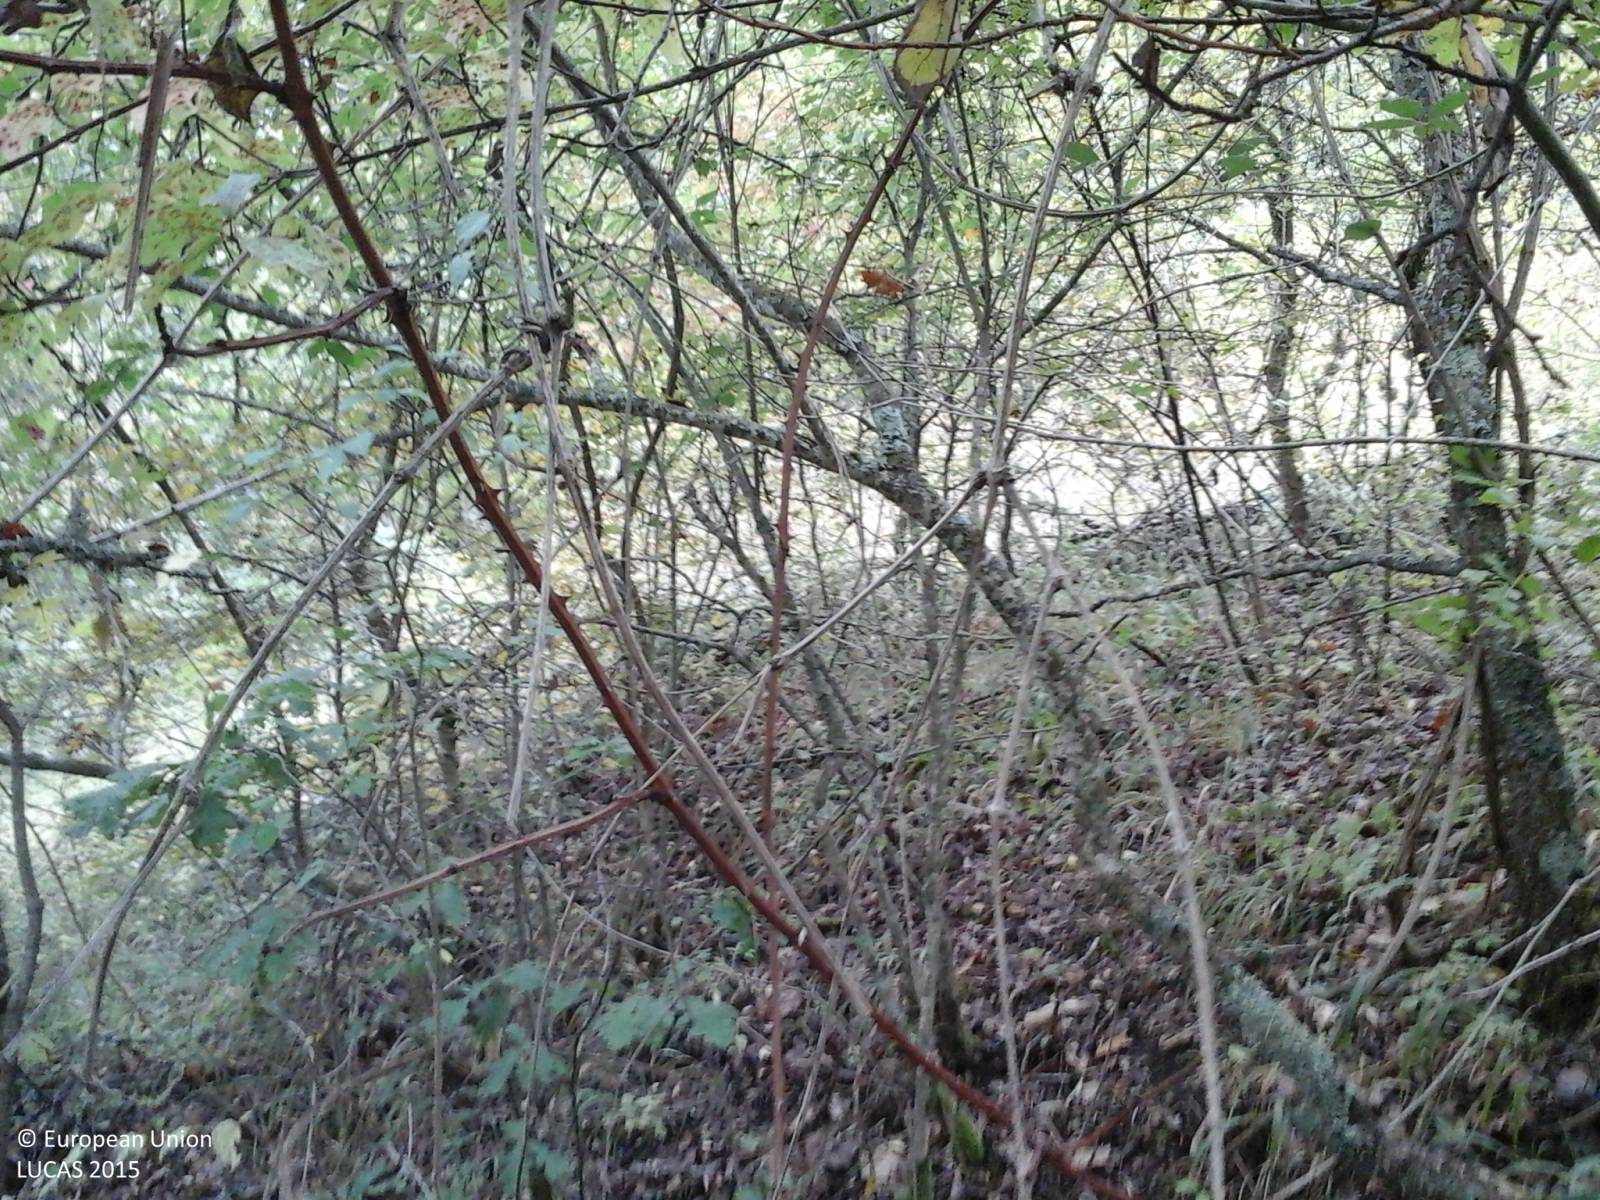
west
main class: Woodland
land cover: Broadleaved woodland
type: thermophilous deciduous forest
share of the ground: > 75 %
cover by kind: broadleaved forest trees 90 %, shrubs 10 %
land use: Forestry
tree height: > 5 m
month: October
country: IT
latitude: 42.6578
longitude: 13.1986
